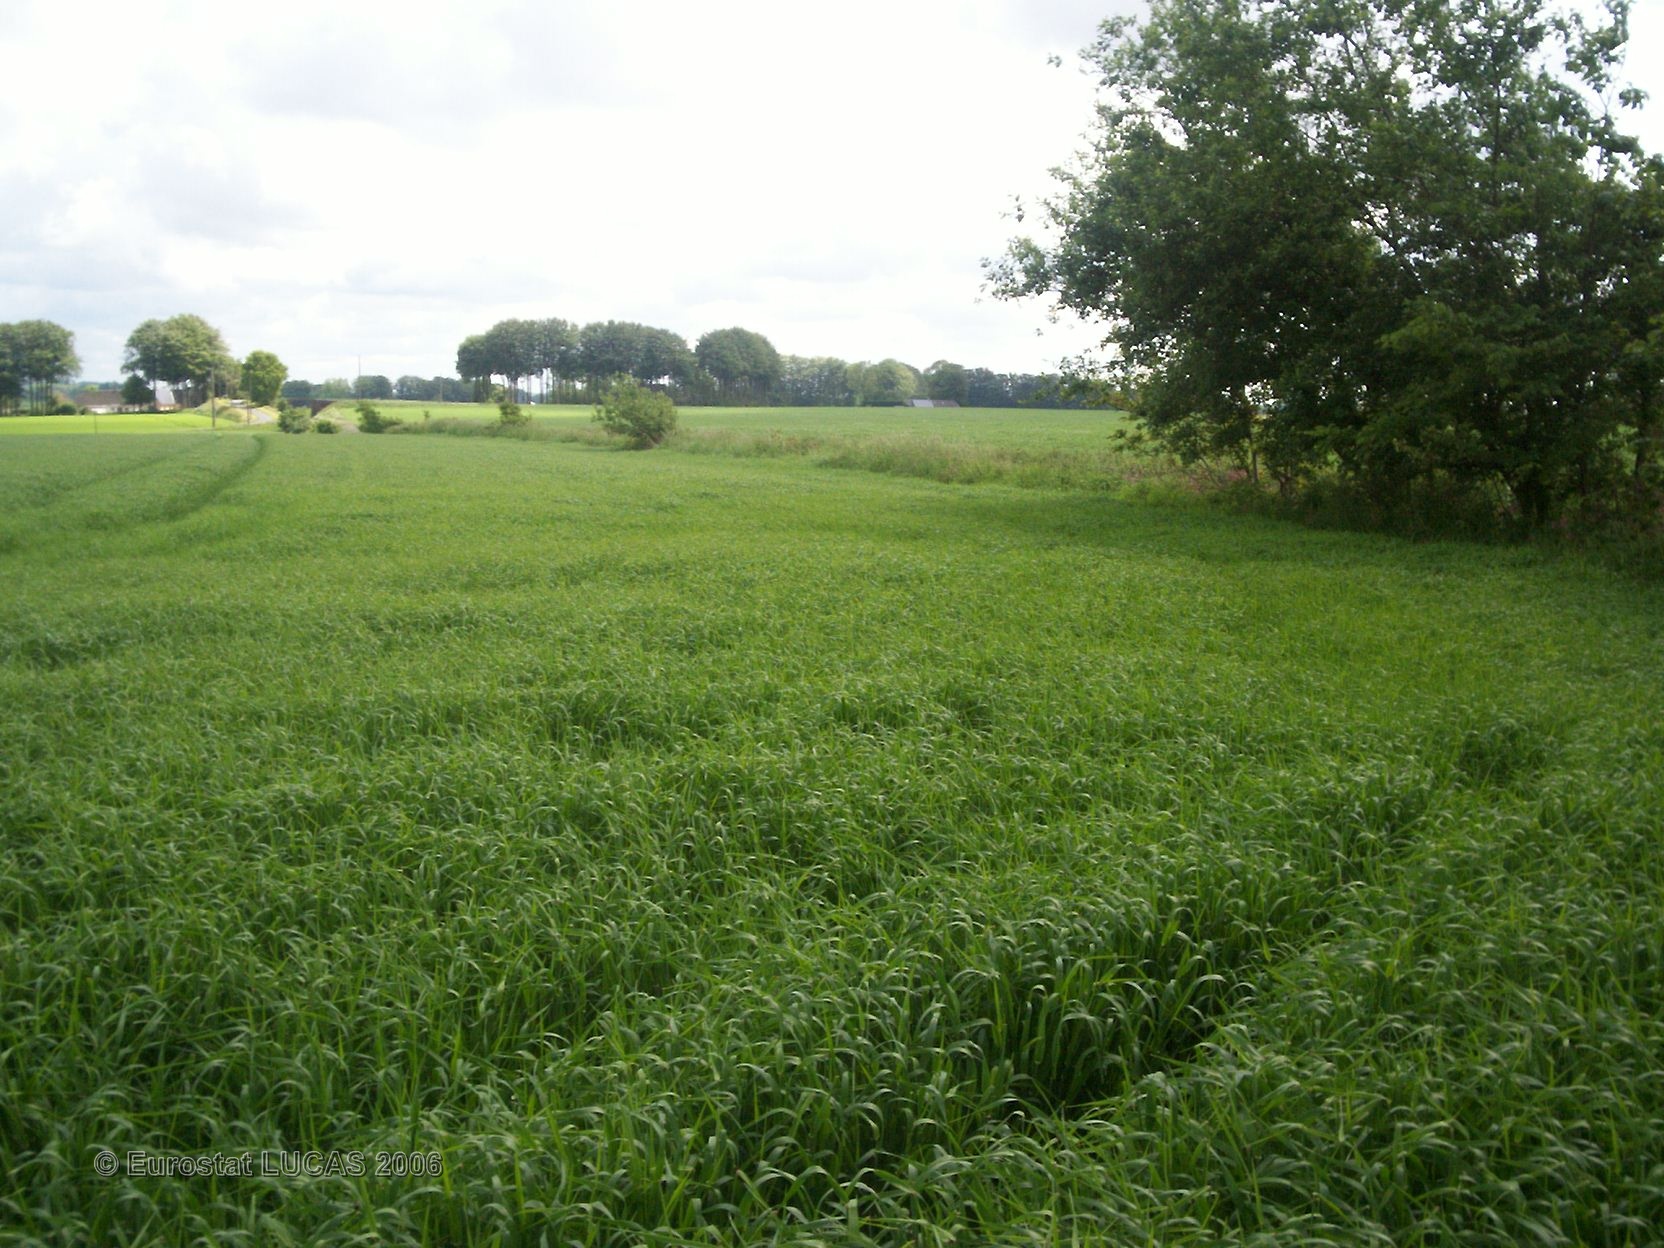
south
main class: Cropland
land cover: Barley
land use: Agriculture (excluding fallow land and kitchen gardens)
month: May
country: FR
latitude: 49.6872
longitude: 0.3941
